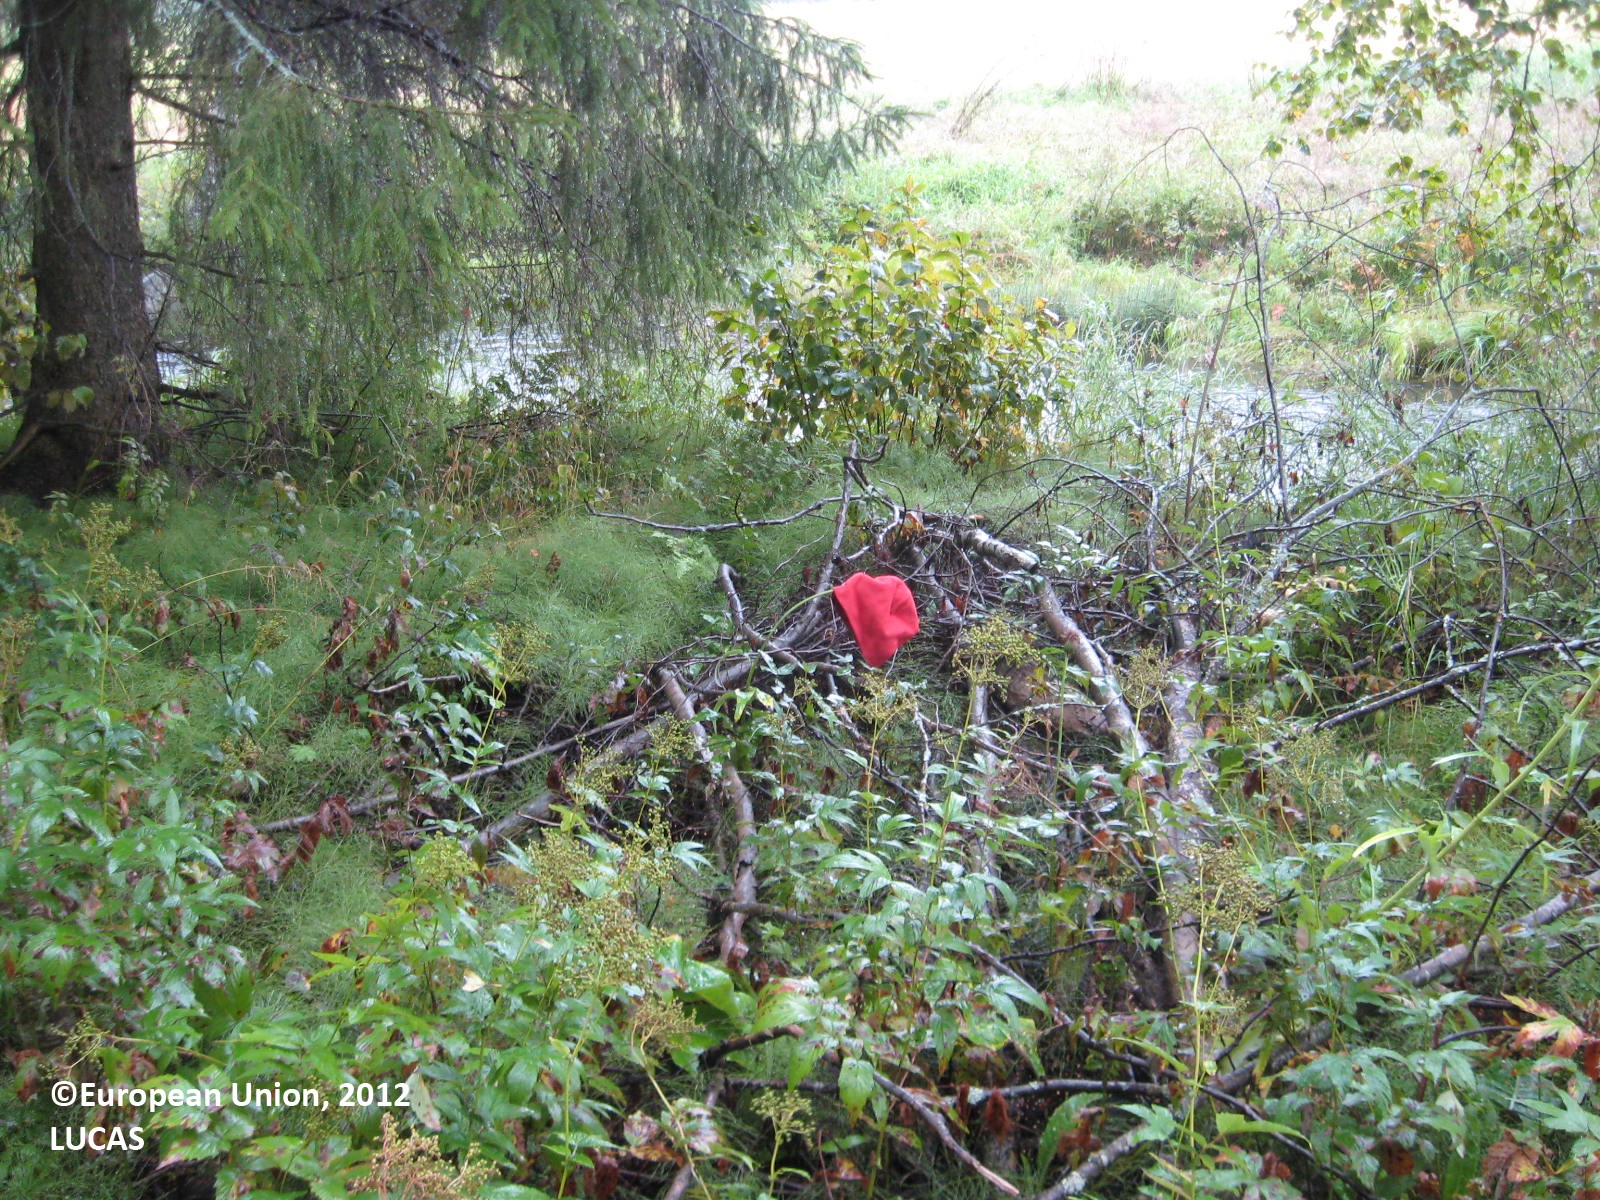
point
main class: Woodland
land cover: Other mixed woodland
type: boreal forest
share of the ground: > 75 %
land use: Forestry
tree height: > 5 m
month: August
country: FI
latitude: 63.5028
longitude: 29.6605
